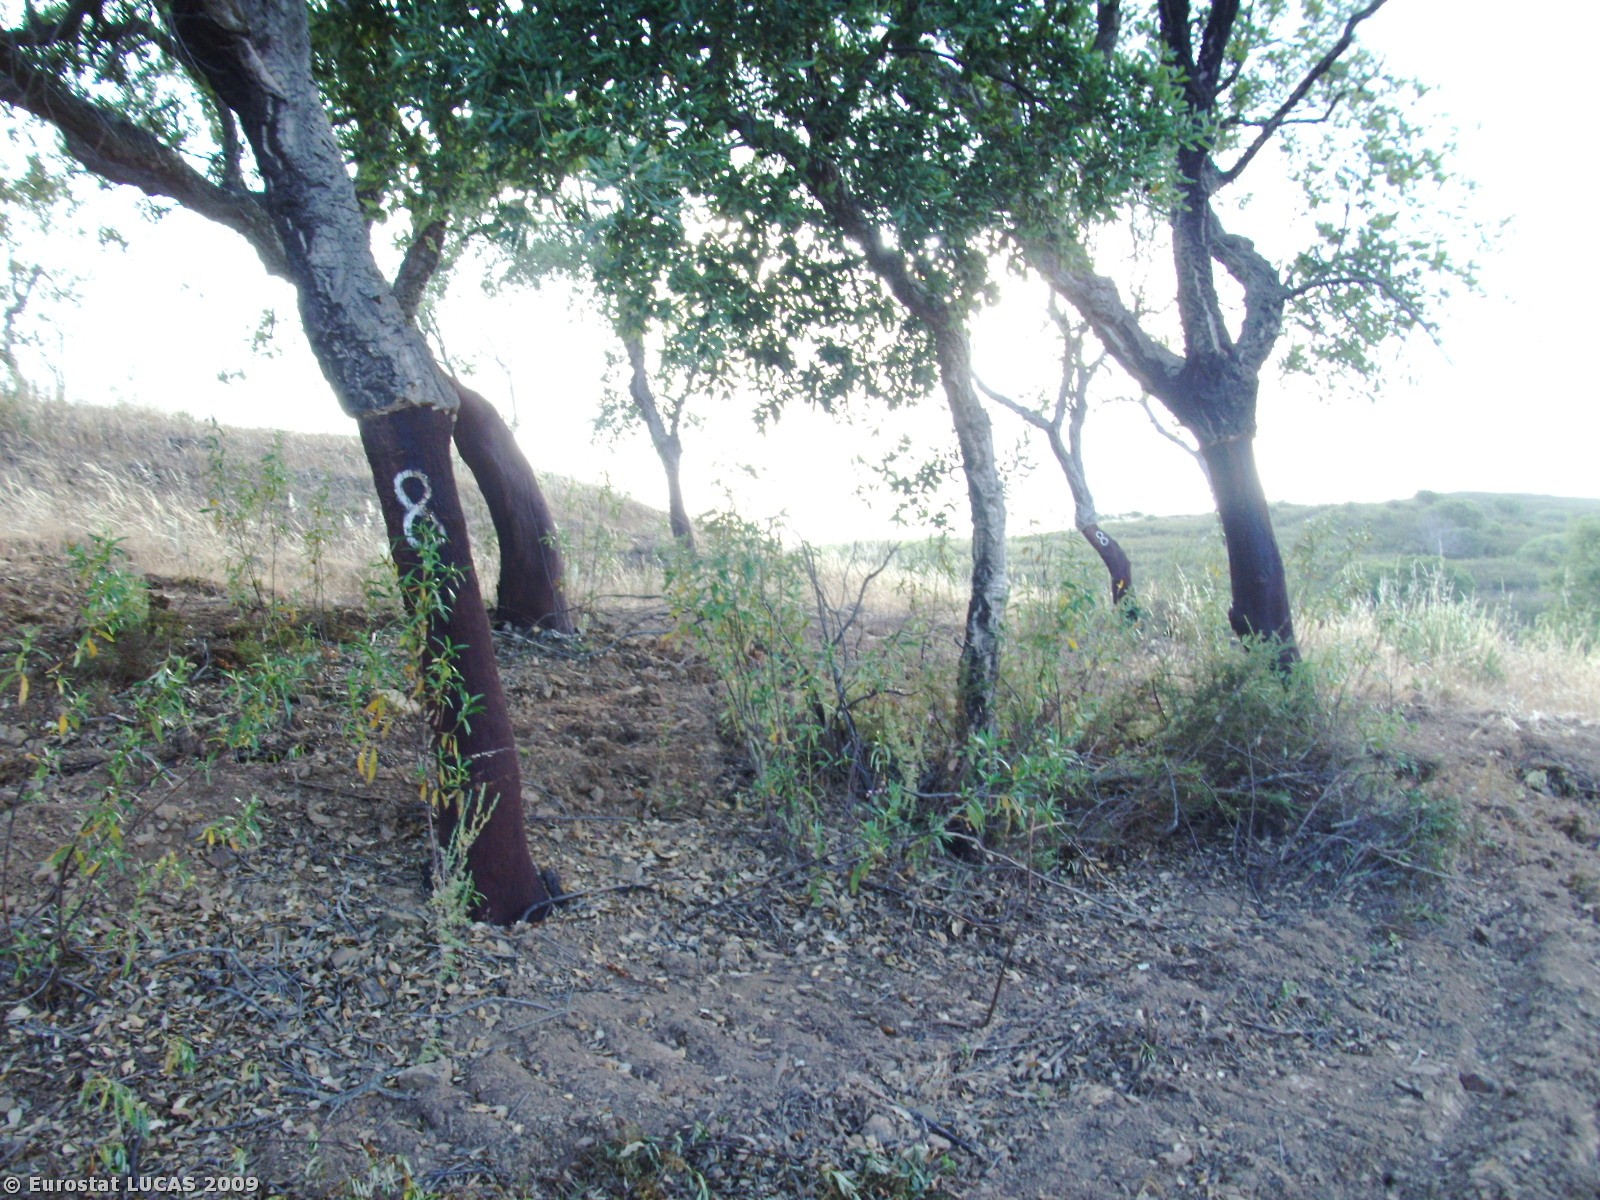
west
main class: Woodland
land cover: Broadleaved woodland
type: broadleaved evergreen forest
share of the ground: 10 - 25 %
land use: Forestry
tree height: > 5 m
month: June
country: PT
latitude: 37.1831
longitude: -8.7412
